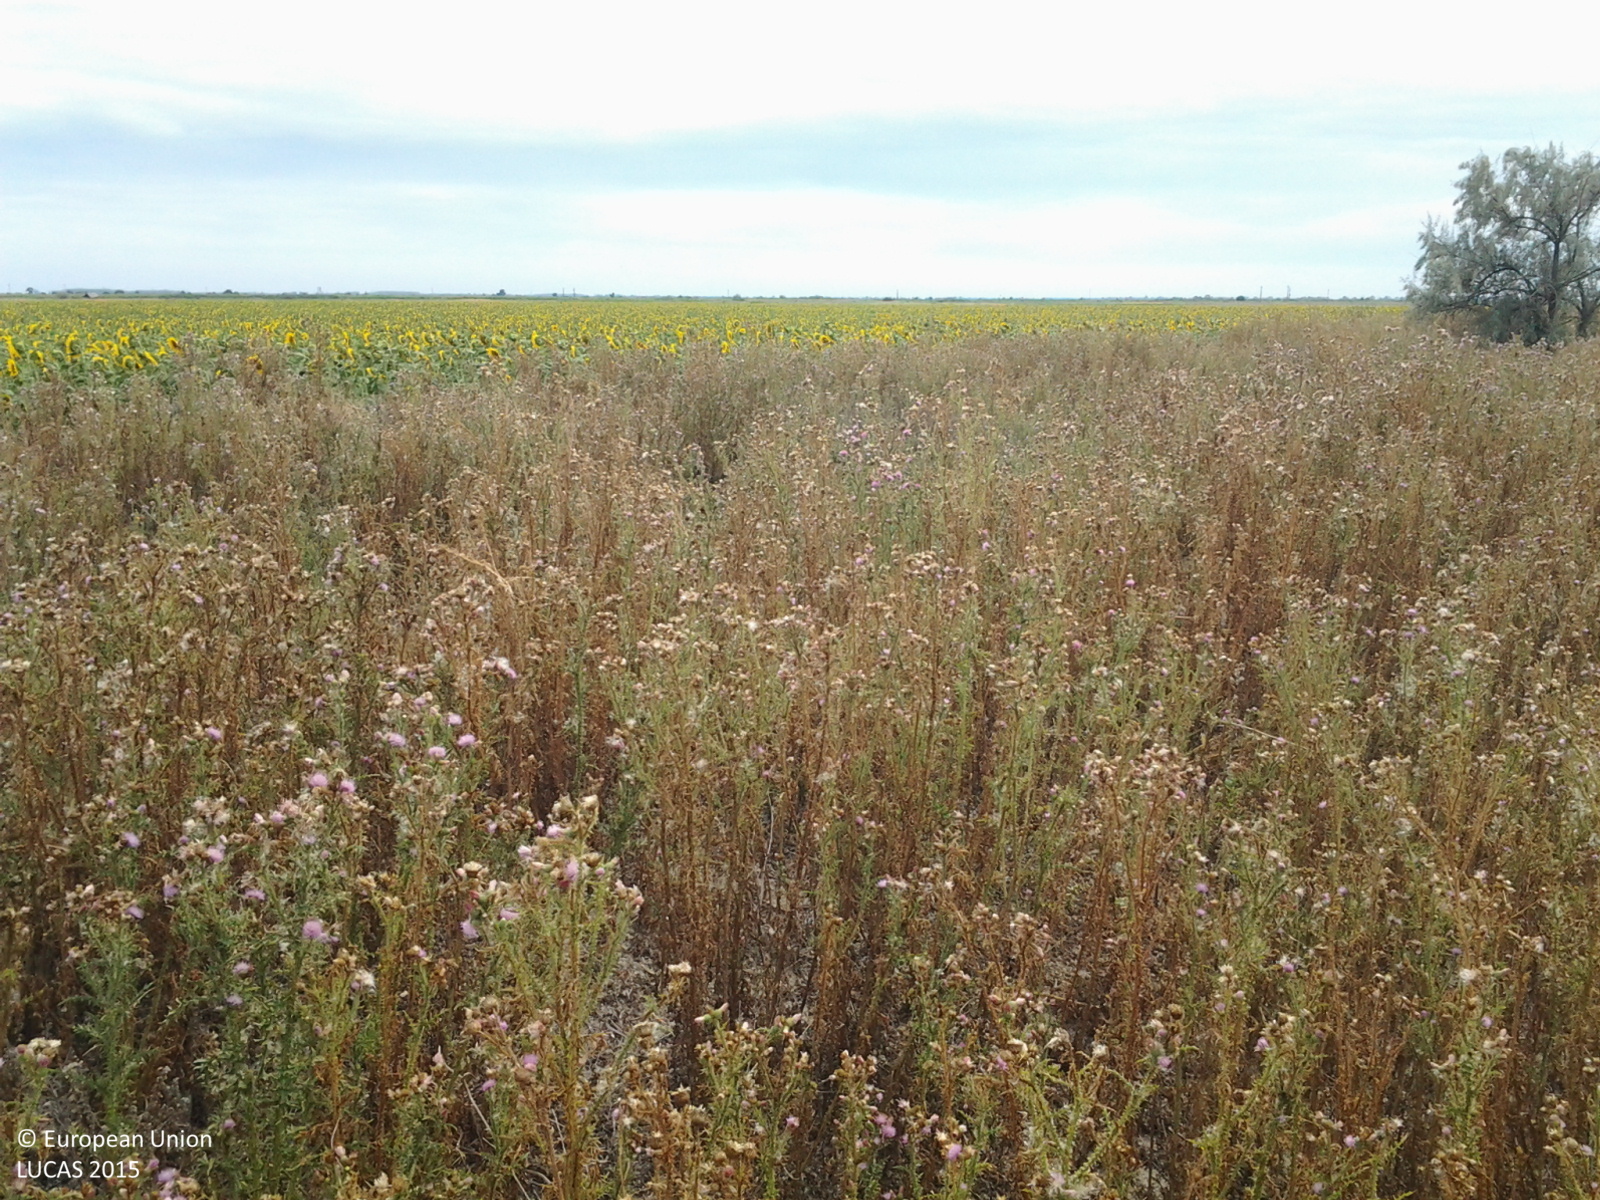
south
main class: Grassland
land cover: Spontaneously vegetated surfaces
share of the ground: > 75 %
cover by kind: herbaceous plants 100 %
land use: Semi-natural and natural areas not in use
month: July
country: HU
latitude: 47.2297
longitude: 20.8775
